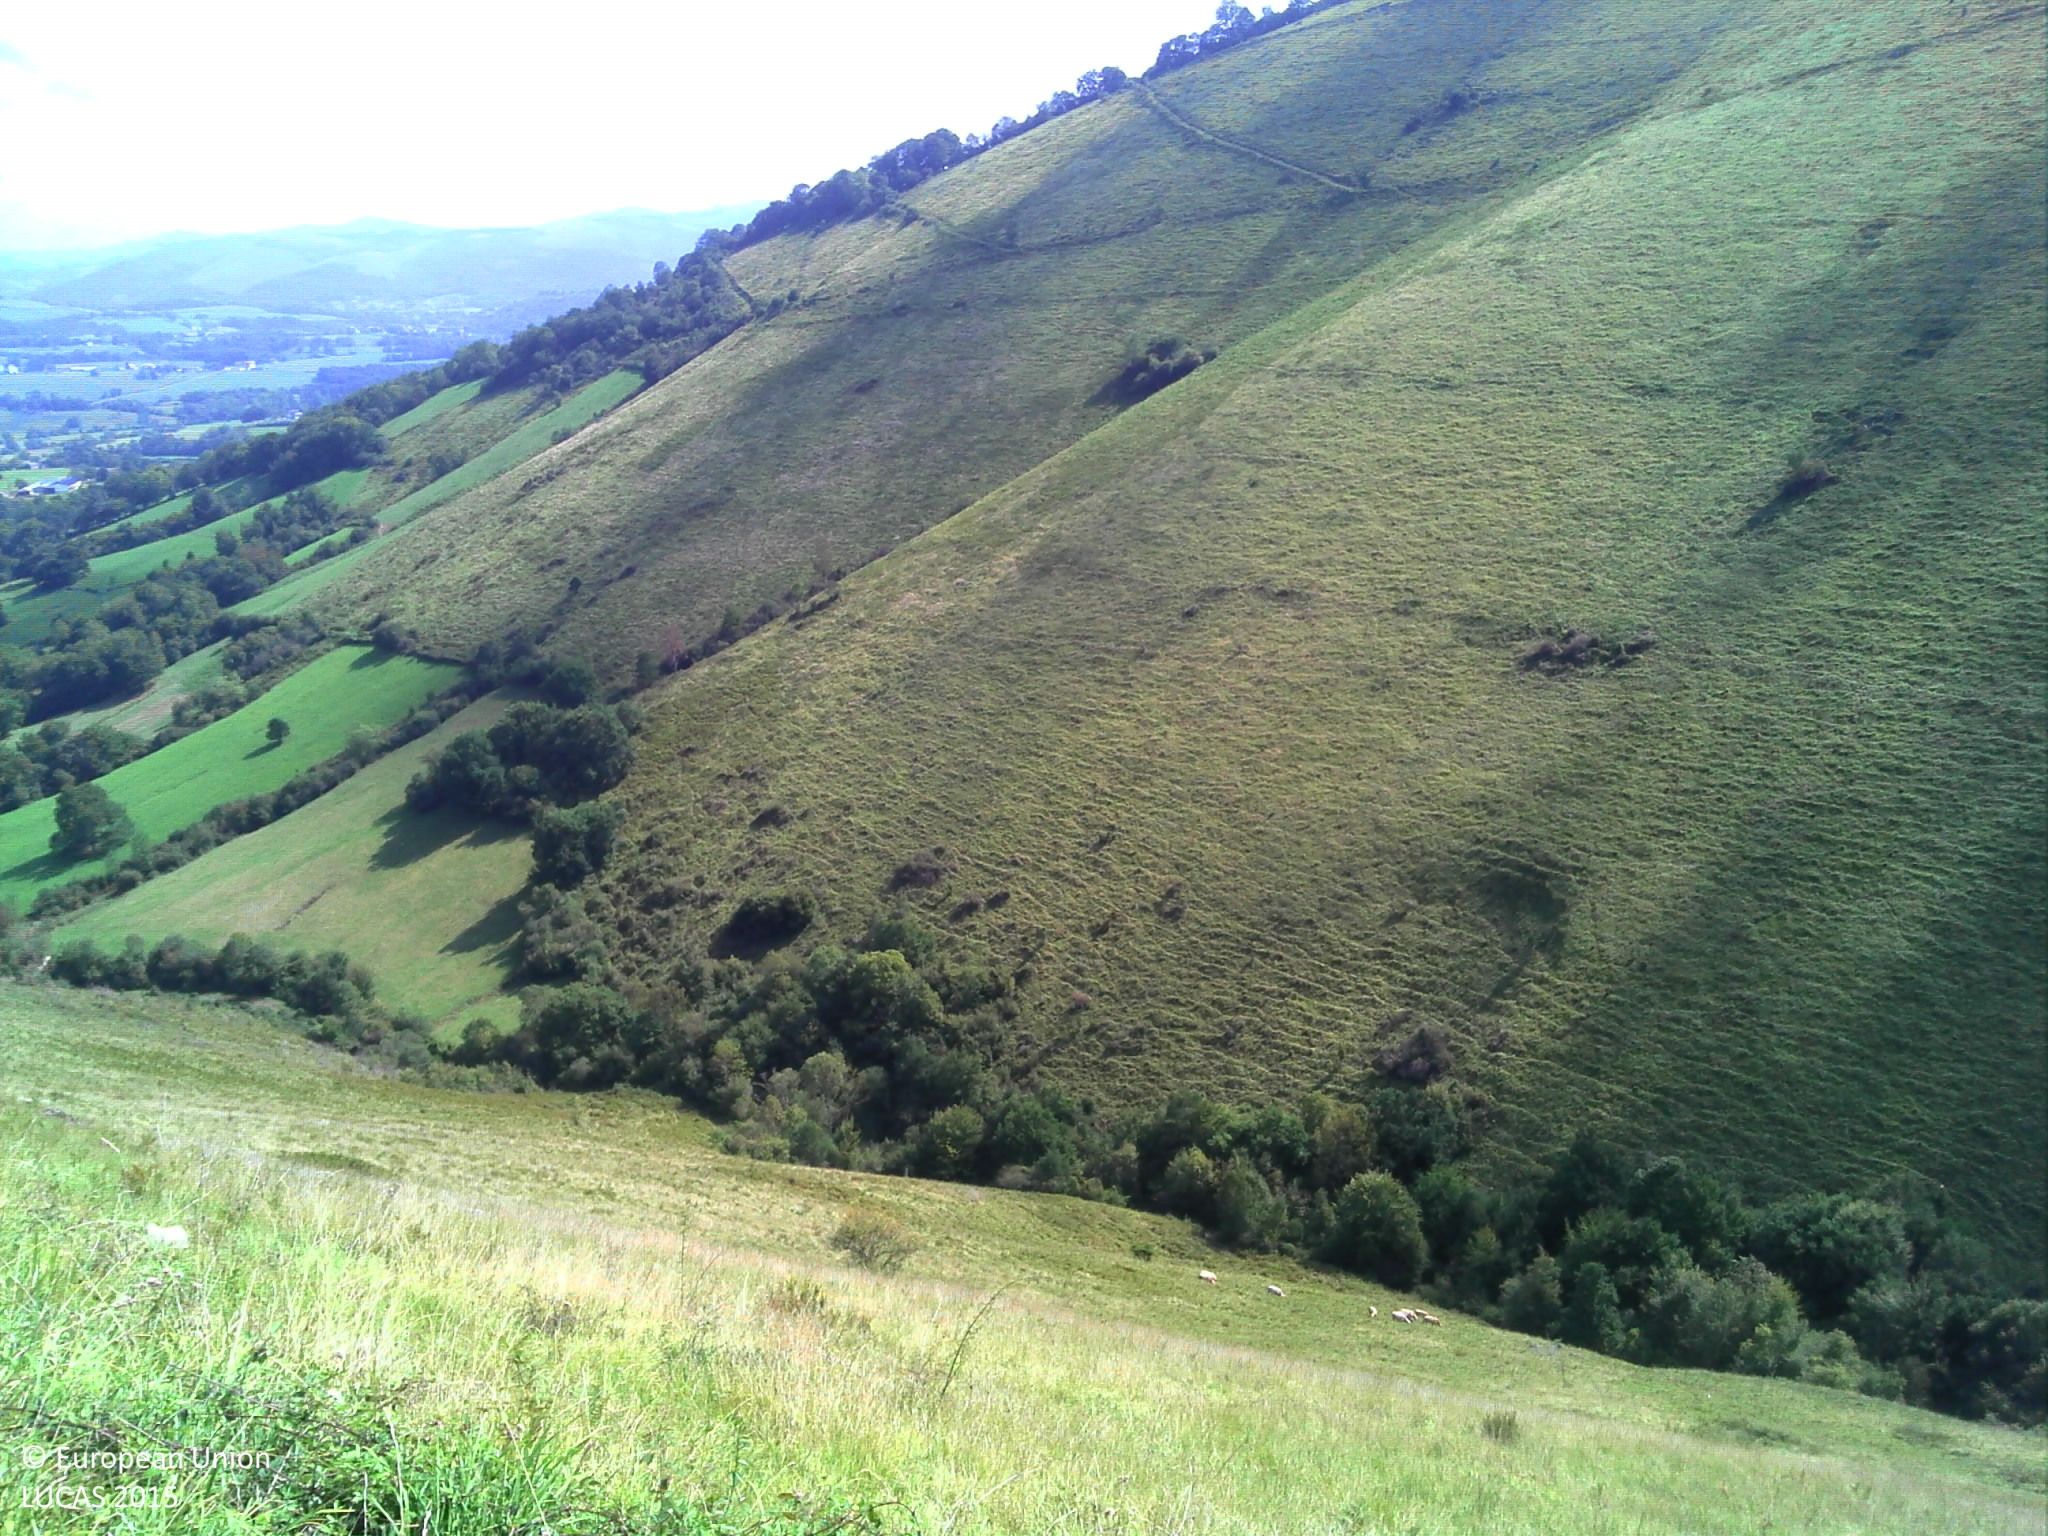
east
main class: Grassland
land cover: Grassland without tree/shrub cover
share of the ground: > 75 %
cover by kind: herbaceous plants 95 %, shrubs 5 %
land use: Agriculture (excluding fallow land and kitchen gardens)
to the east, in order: Grassland without tree/shrub cover; Broadleaved woodland; Rivers and streams; Broadleaved woodland; Grassland with sparse tree/shrub cover; Grassland without tree/shrub cover
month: September
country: FR
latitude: 43.1820
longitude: -0.9979
